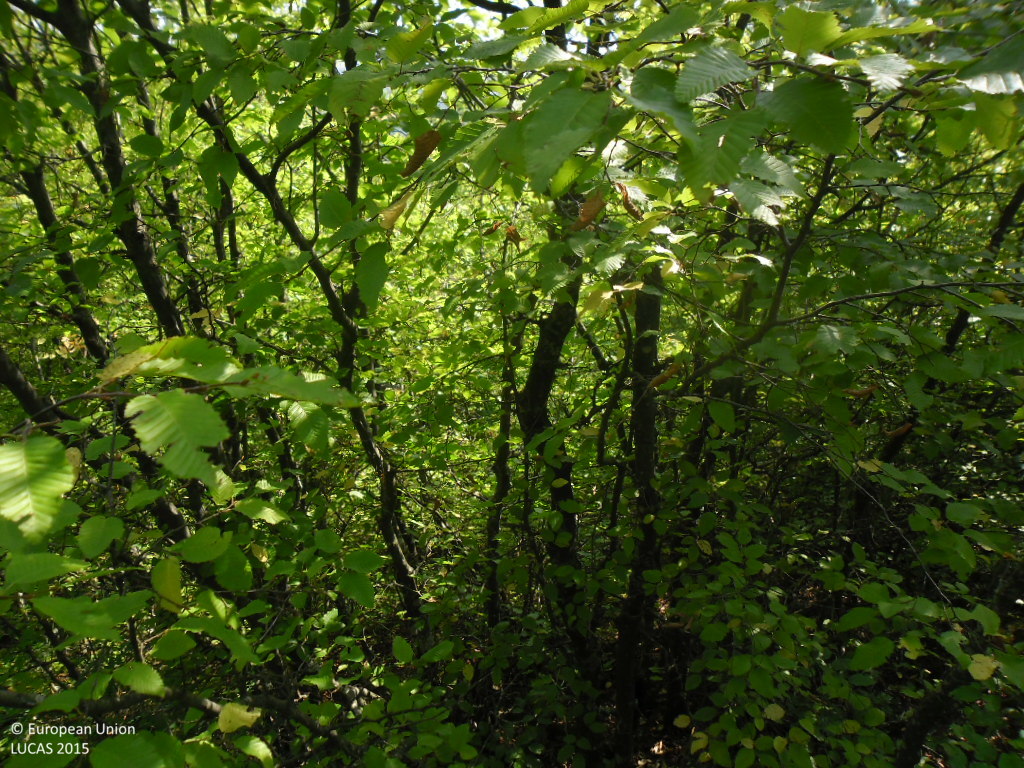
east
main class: Woodland
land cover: Broadleaved woodland
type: mesophytic deciduous forest
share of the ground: > 75 %
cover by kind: broadleaved forest trees 90 %, unconsolidated bare surface 10 %
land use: Forestry
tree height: < 5 m
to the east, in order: Broadleaved woodland
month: September
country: BG
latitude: 41.9301
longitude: 22.9371
